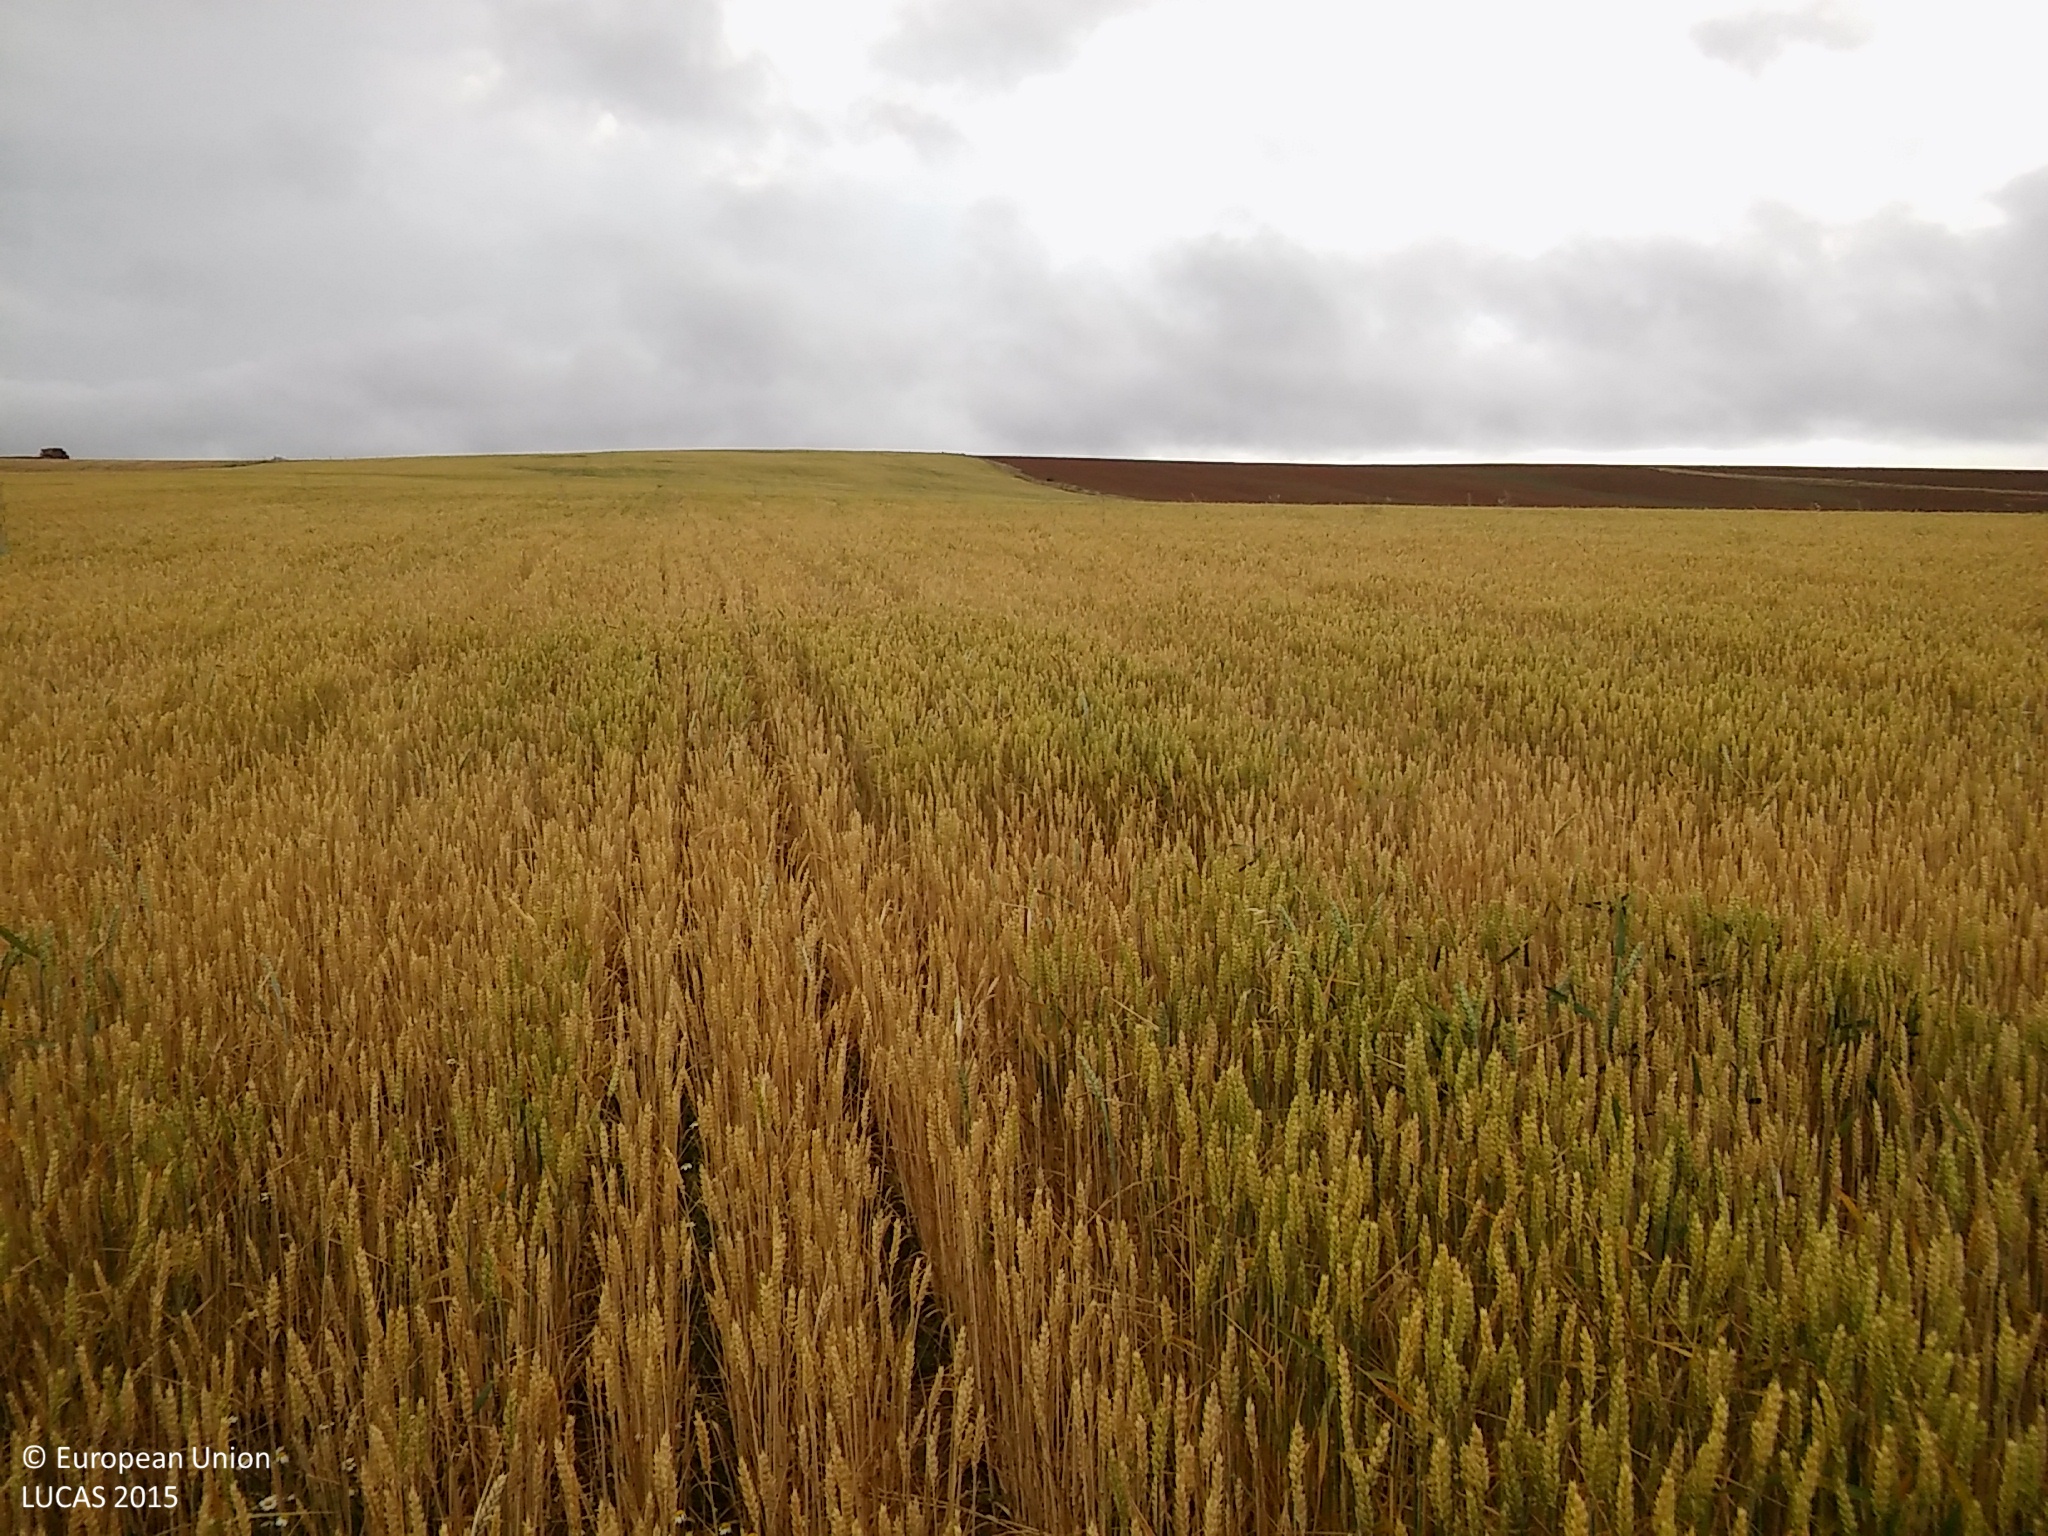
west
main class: Cropland
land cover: Common wheat
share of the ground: > 75 %
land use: Agriculture (excluding fallow land and kitchen gardens)
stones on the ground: 10 - 25 %
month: June
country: ES
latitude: 41.2233
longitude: -3.7062
